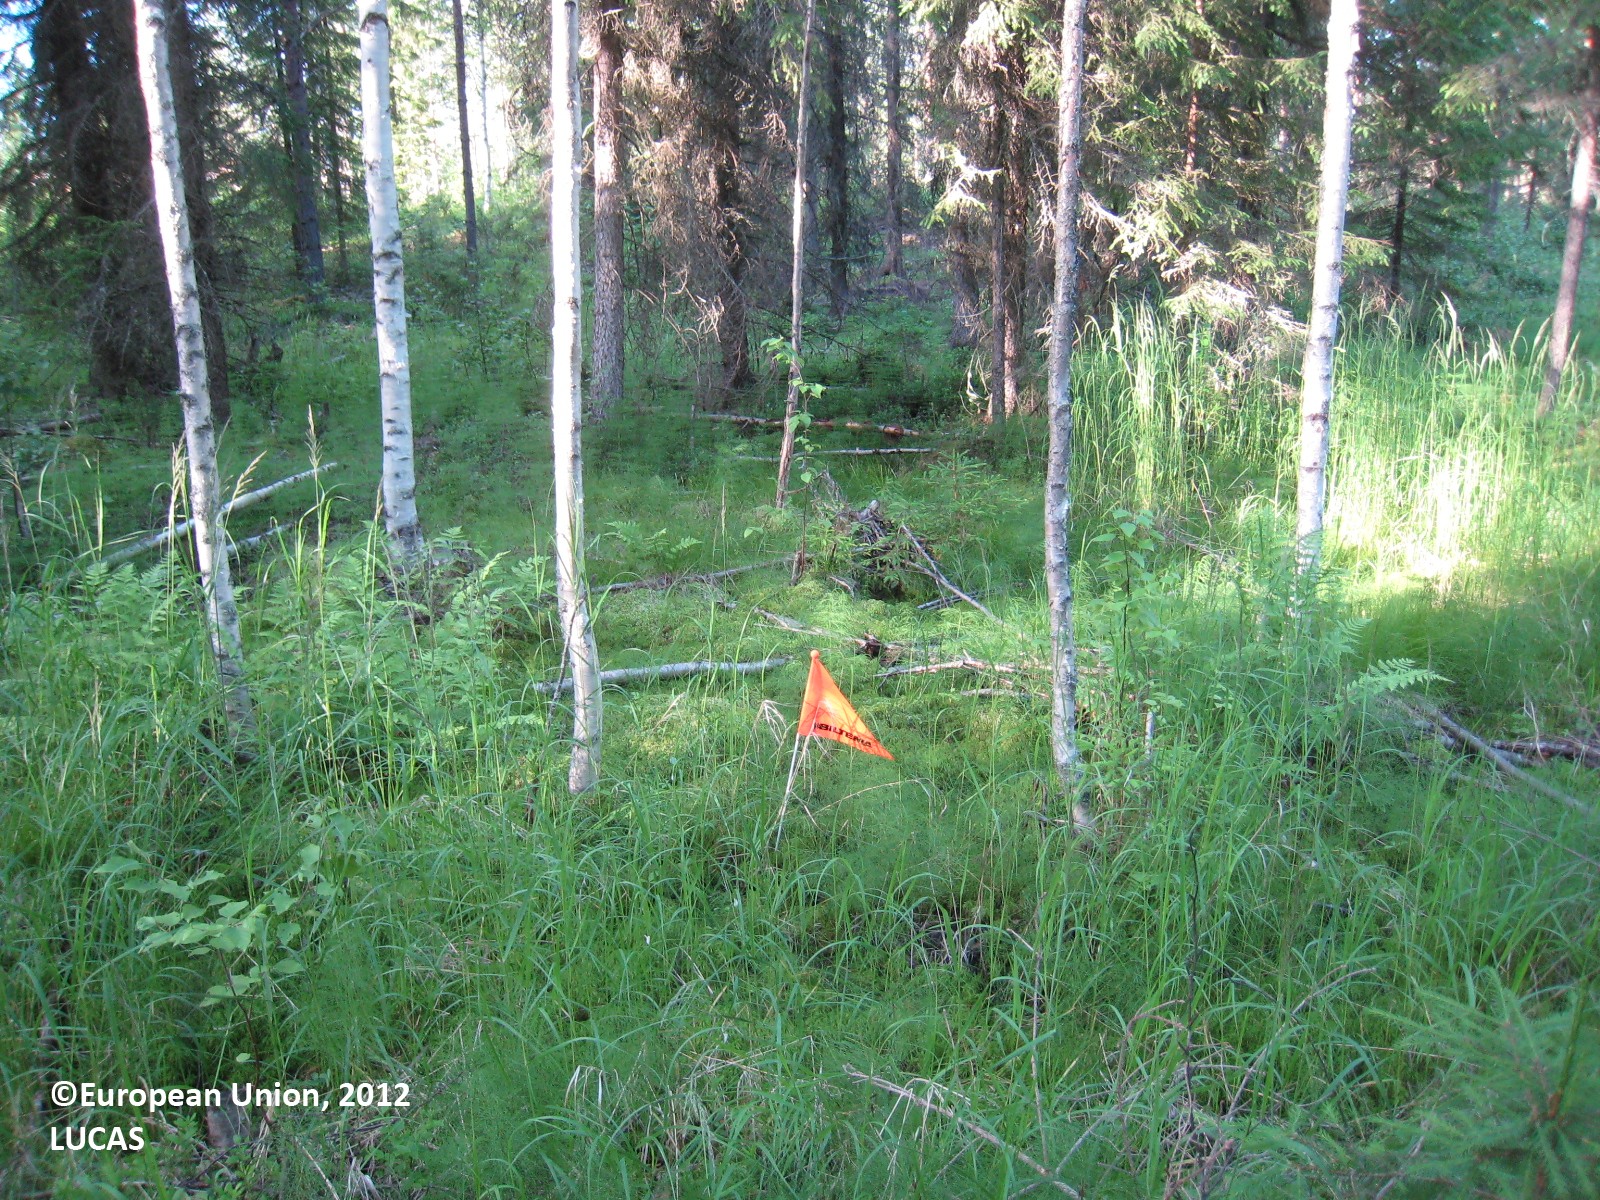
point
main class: Woodland
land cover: Spruce dominated mixed woodland
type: boreal forest
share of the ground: 50 - 75 %
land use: Forestry
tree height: > 5 m
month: July
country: FI
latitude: 63.1486
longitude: 25.6876
